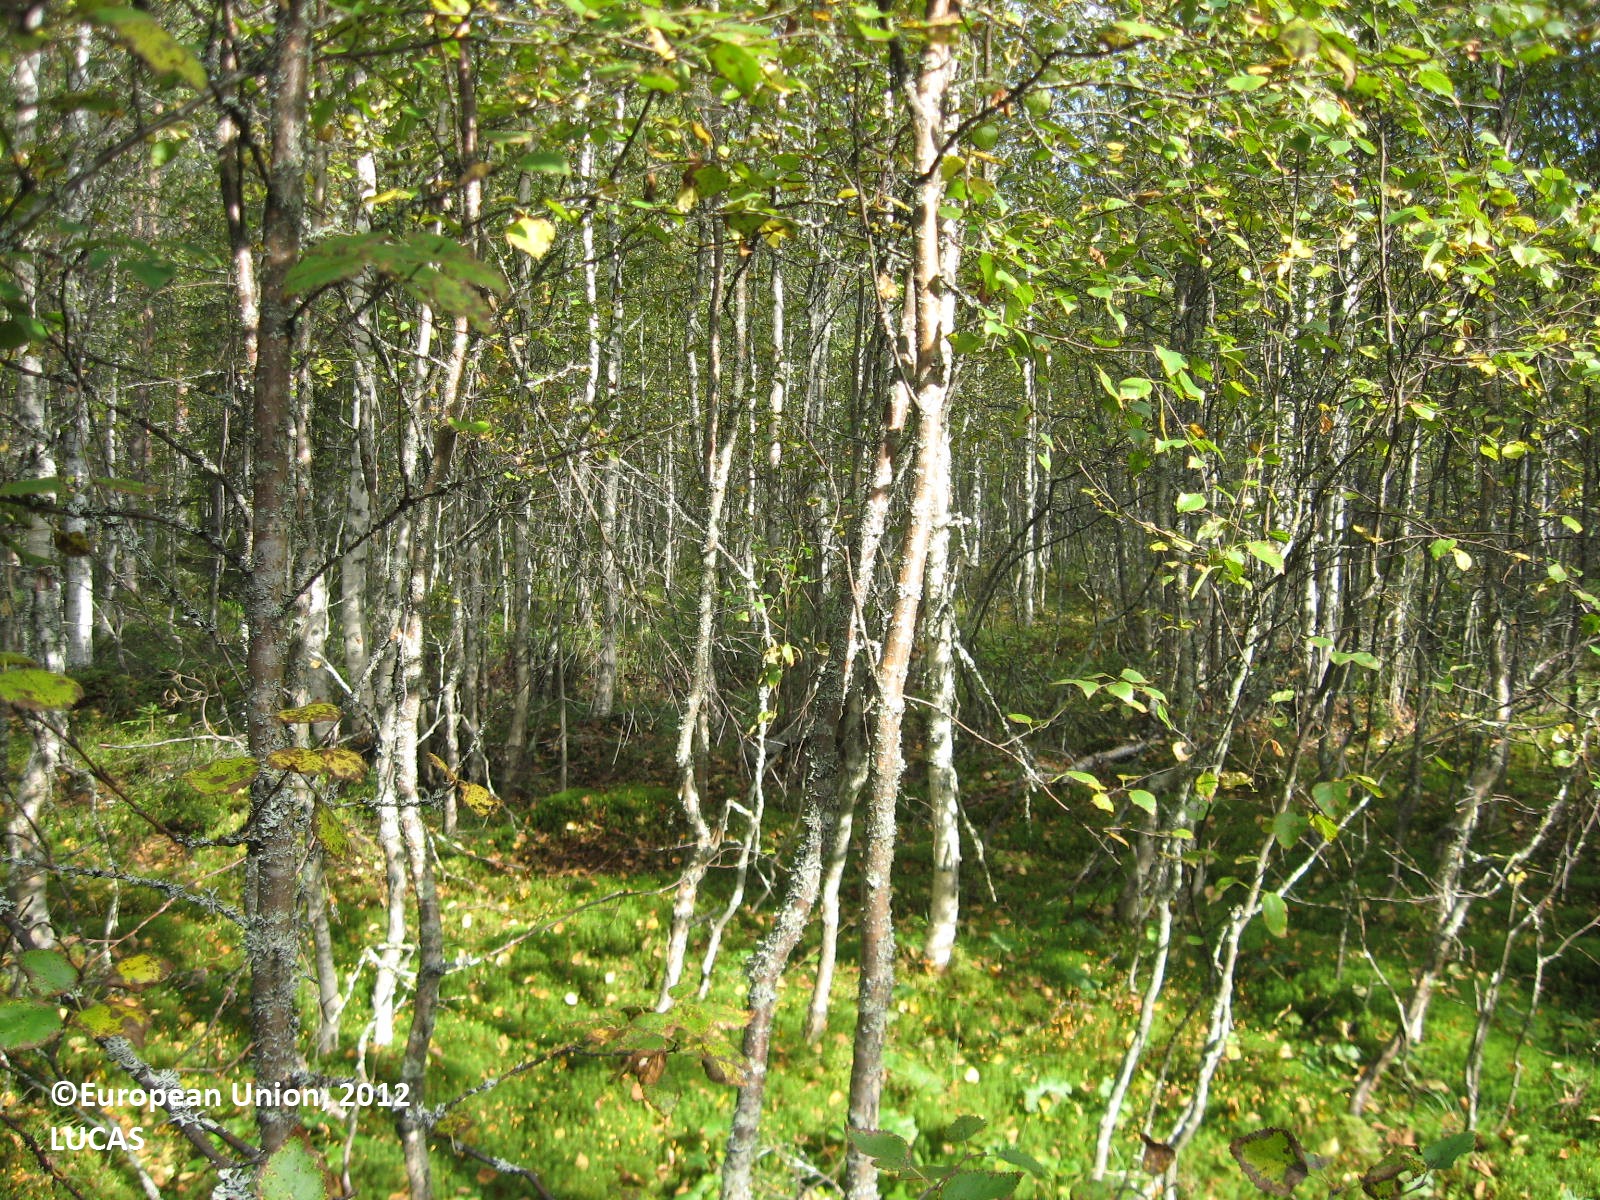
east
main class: Woodland
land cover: Other coniferous woodland
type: boreal forest
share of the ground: > 75 %
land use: Forestry
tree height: > 5 m
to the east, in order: Other coniferous woodland; Ditches and canals; Other coniferous woodland; Ditches and canals; Other coniferous woodland; Ditches and canals; Other coniferous woodland; Ditches and canals; Other coniferous woodland; Ditches and canals; Other coniferous woodland
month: August
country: FI
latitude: 63.8155
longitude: 29.1186
